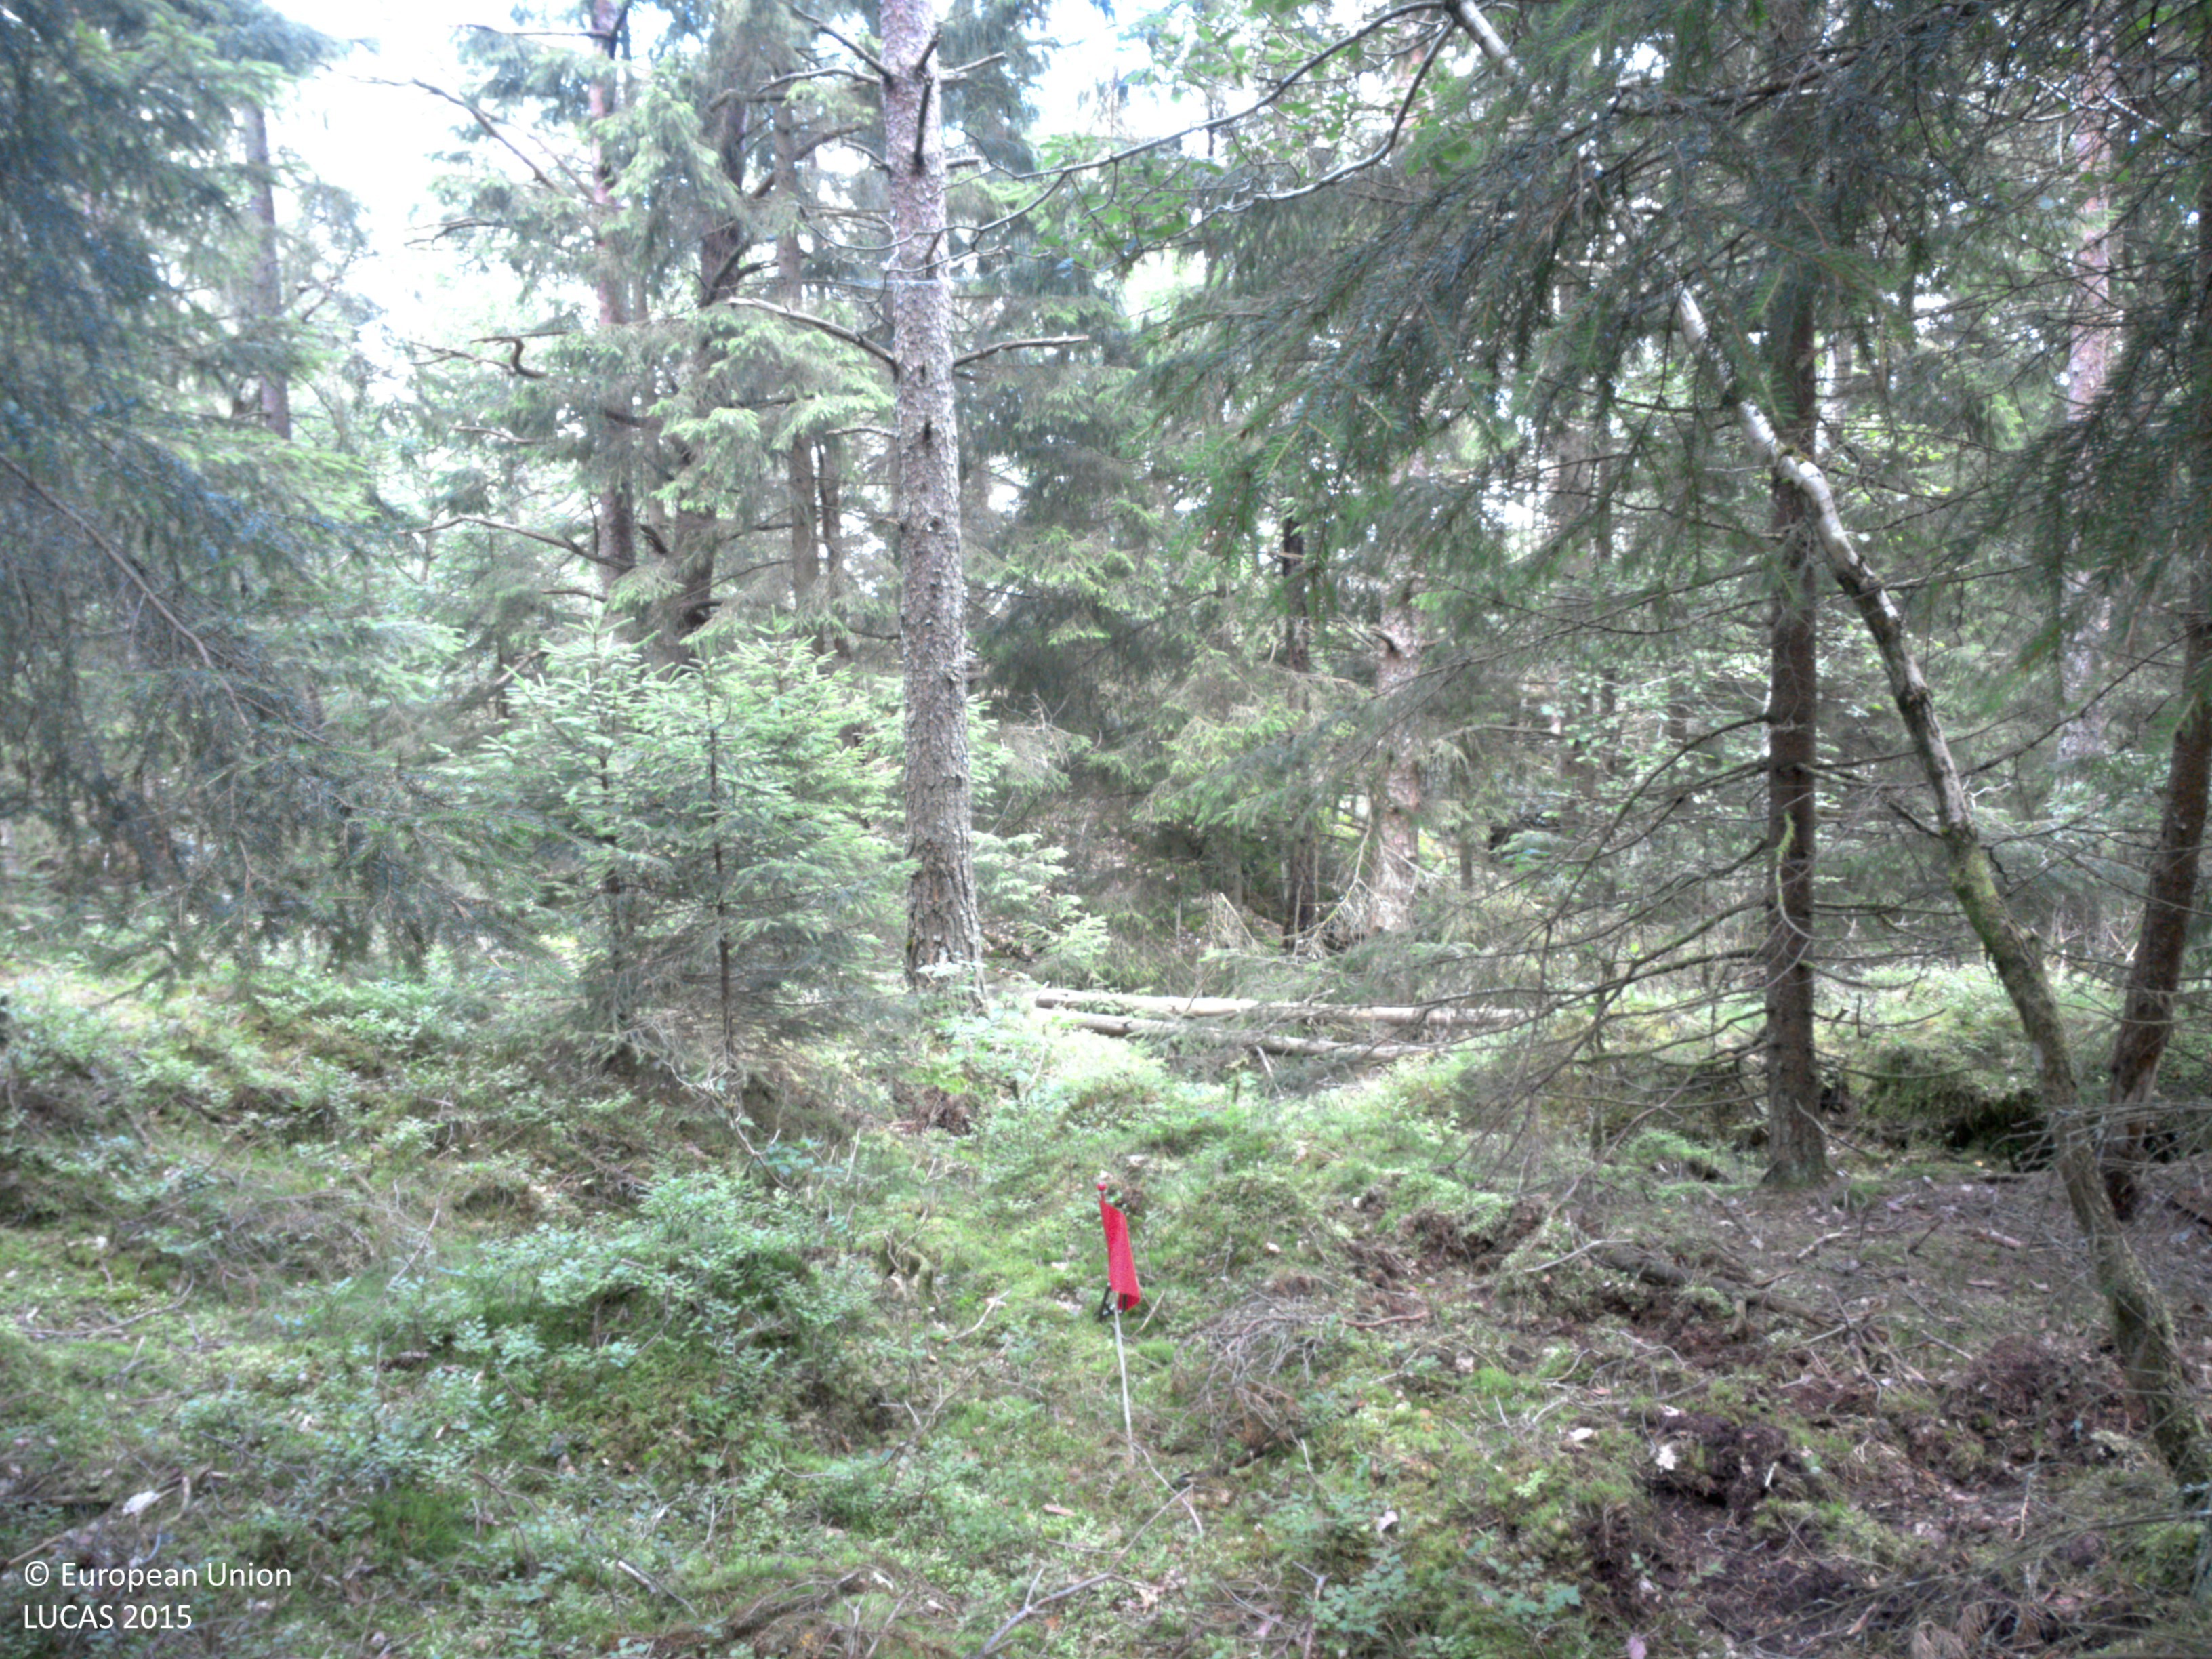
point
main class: Woodland
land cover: Other coniferous woodland
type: boreal forest
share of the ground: 50 - 75 %
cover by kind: coniferous forest trees 50 %, lichens and mosses 35 %, shrubs 15 %
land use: Forestry
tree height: > 5 m
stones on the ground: < 10 %
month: August
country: SE
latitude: 57.9352
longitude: 11.9725
